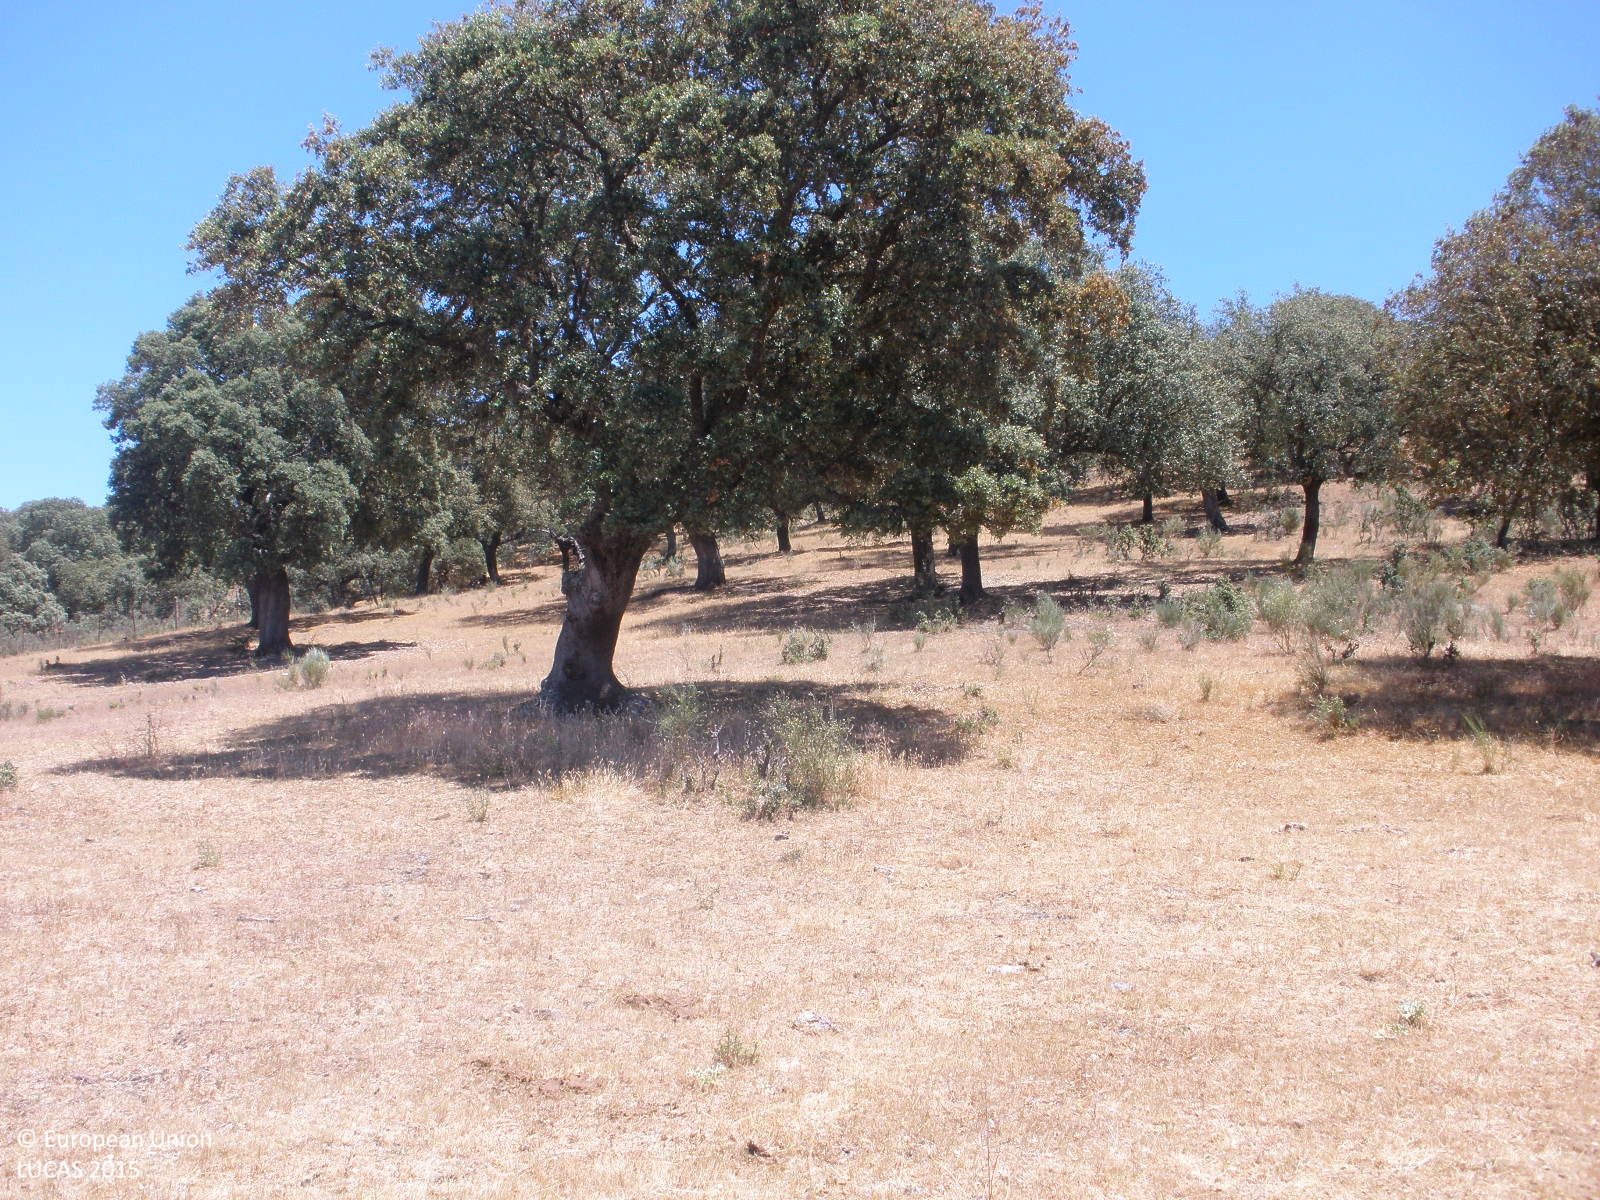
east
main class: Woodland
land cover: Broadleaved woodland
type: broadleaved evergreen forest
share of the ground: 25 - 50 %
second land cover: Grassland without tree/shrub cover
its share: > 75 %
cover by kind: herbaceous plants 60 %, broadleaved forest trees 30 %, shrubs 10 %
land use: Forestry
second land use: Agriculture (excluding fallow land and kitchen gardens)
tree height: > 5 m
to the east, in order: Broadleaved woodland; Grassland without tree/shrub cover; Fences; Broadleaved woodland
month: June
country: ES
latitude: 40.4669
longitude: -6.6852
